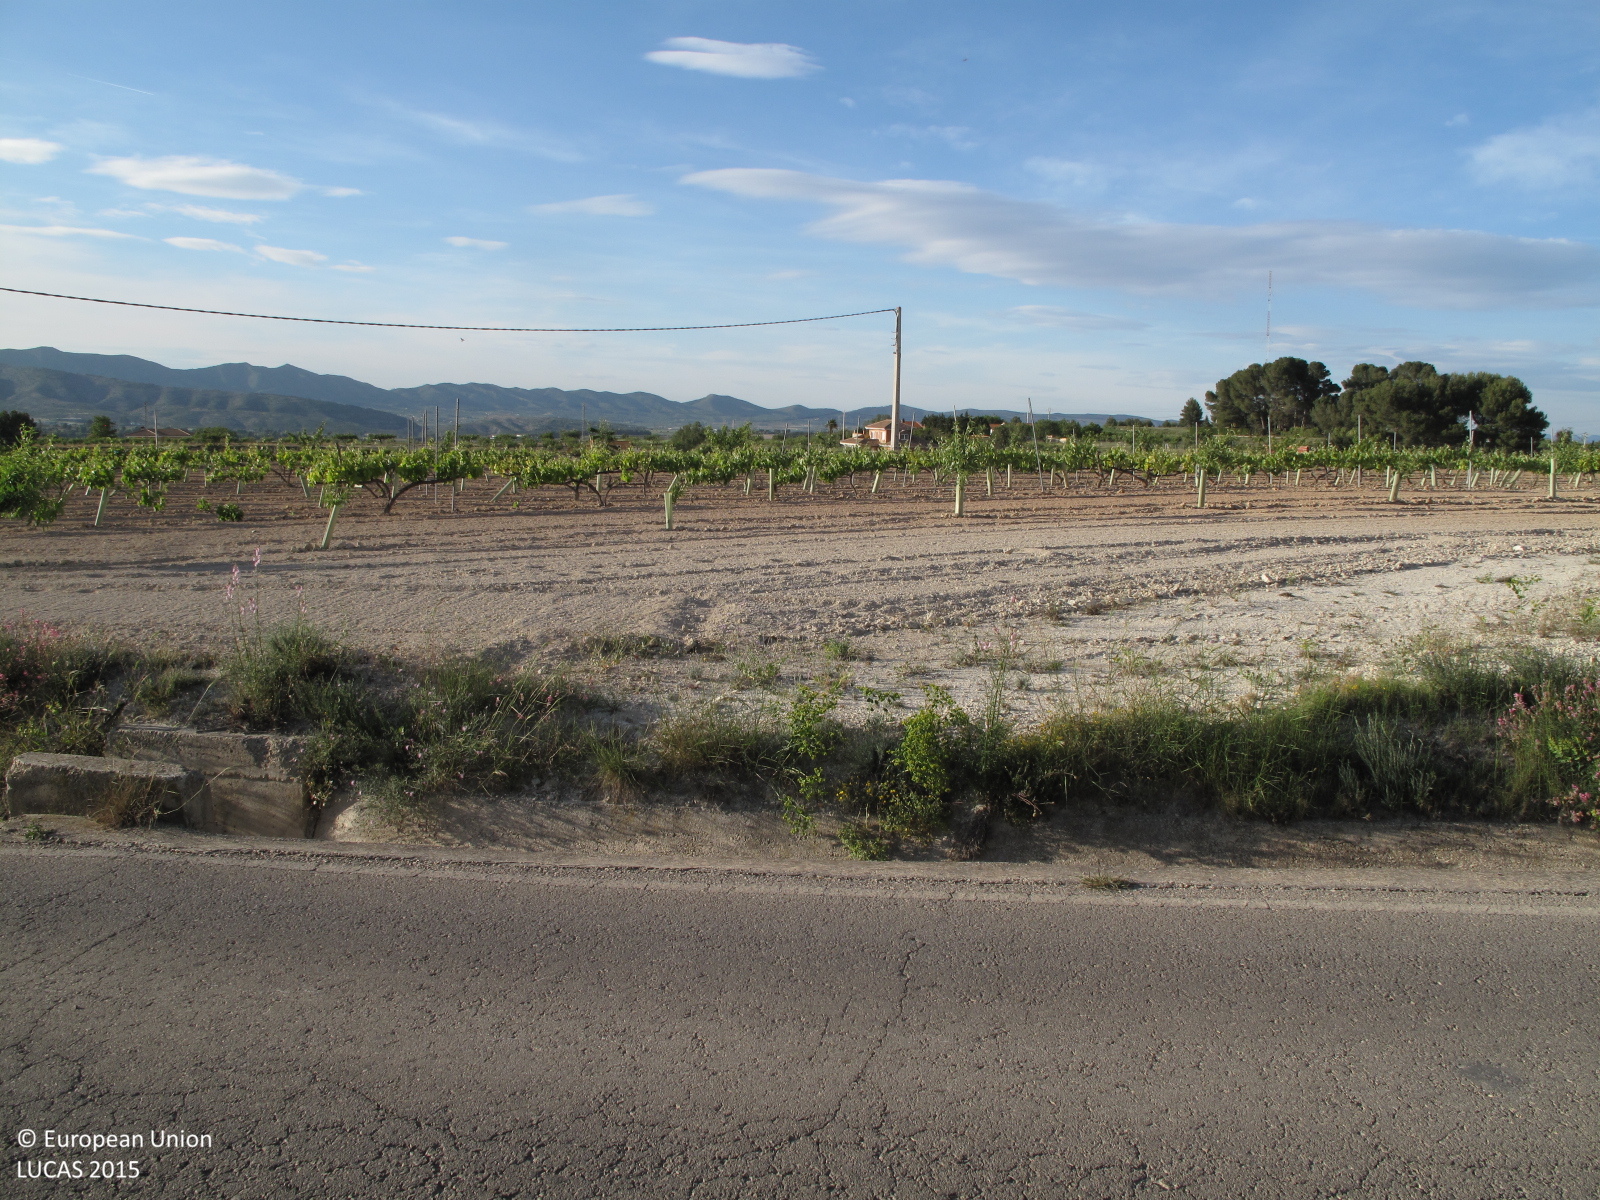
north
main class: Cropland
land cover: Olive groves
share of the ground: 50 - 75 %
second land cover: Other bare soil
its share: > 75 %
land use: Agriculture (excluding fallow land and kitchen gardens)
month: May
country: ES
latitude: 38.8184
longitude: -0.5755
